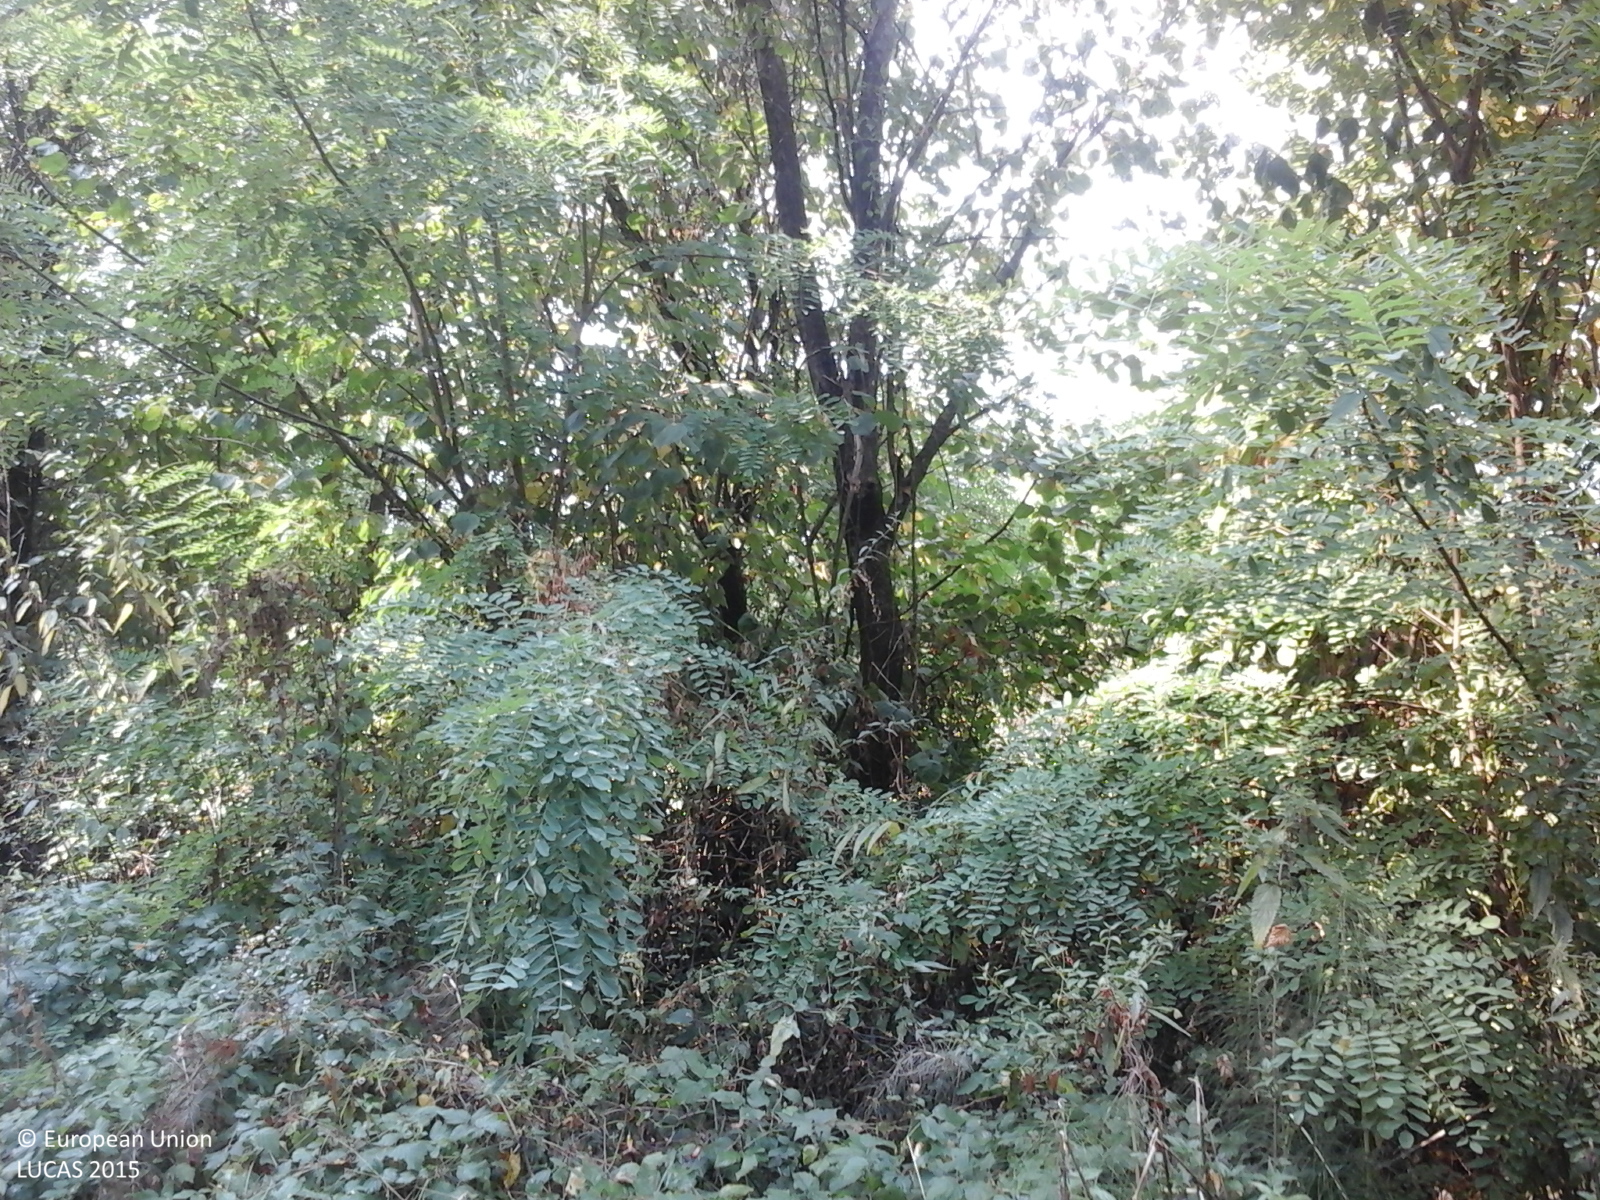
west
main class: Woodland
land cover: Broadleaved woodland
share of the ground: > 75 %
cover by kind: broadleaved forest trees 60 %, shrubs 40 %
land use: Abandoned areas
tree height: > 5 m
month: September
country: RO
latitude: 47.5384
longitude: 23.6134
